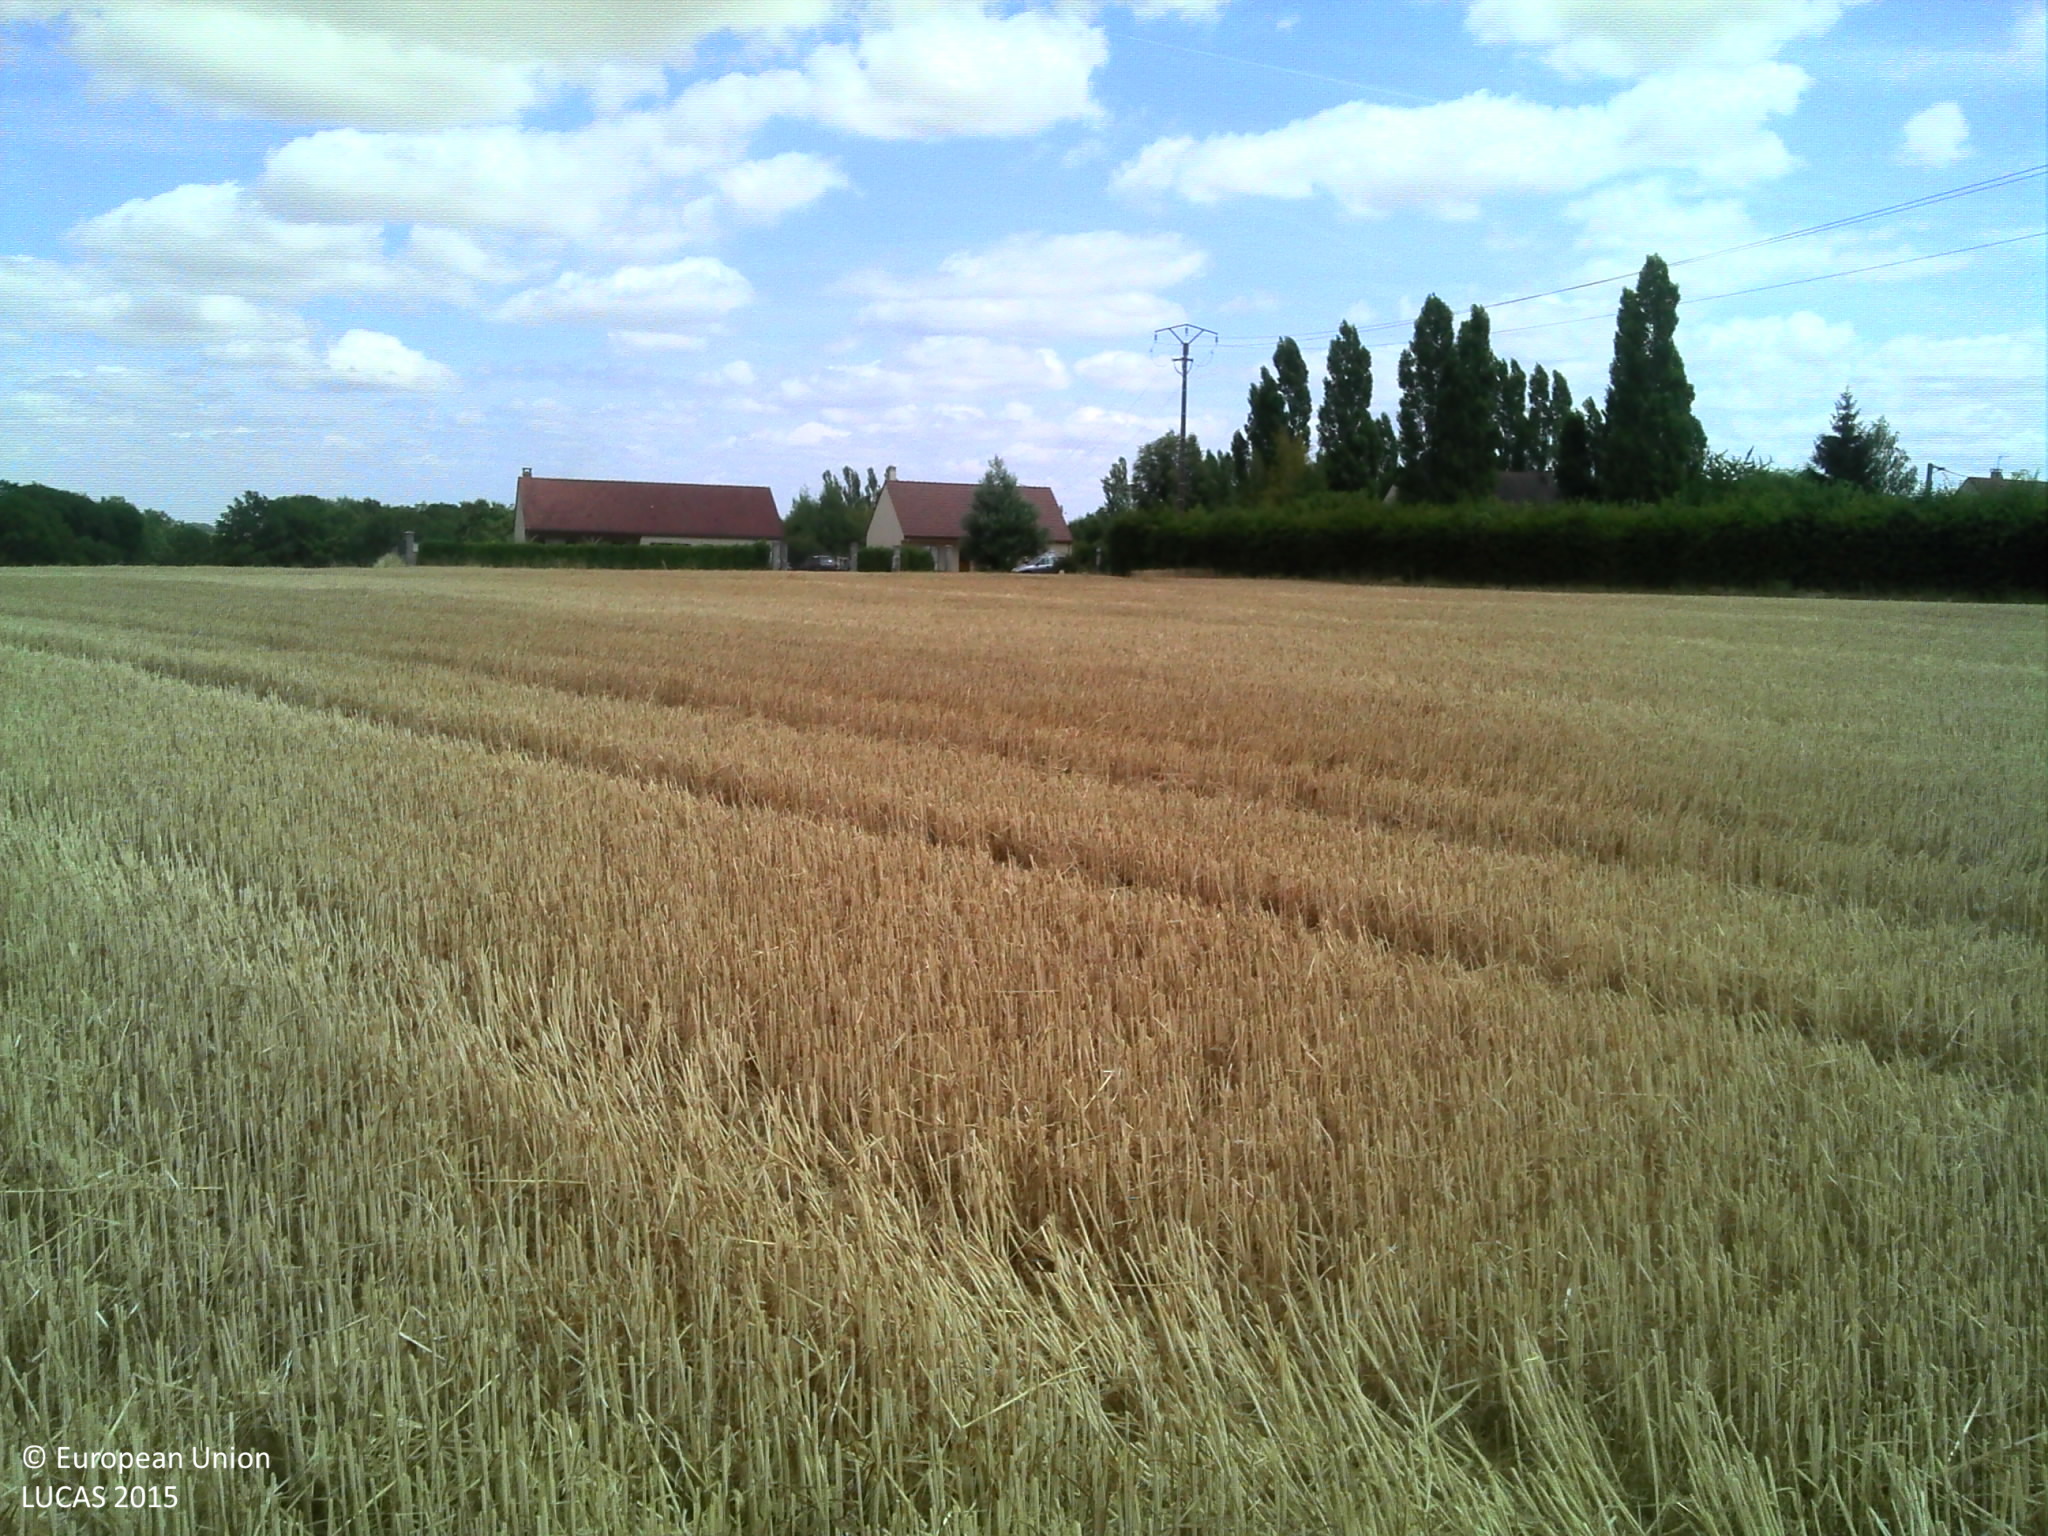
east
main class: Cropland
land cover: Common wheat
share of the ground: > 75 %
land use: Agriculture (excluding fallow land and kitchen gardens)
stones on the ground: 10 - 25 %
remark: Harvested field
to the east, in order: Common wheat; Artificial constructions in urban areas; Grassland with sparse tree/shrub cover; Broadleaved woodland; Fences; Broadleaved woodland
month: July
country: FR
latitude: 47.7218
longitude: 3.4498
